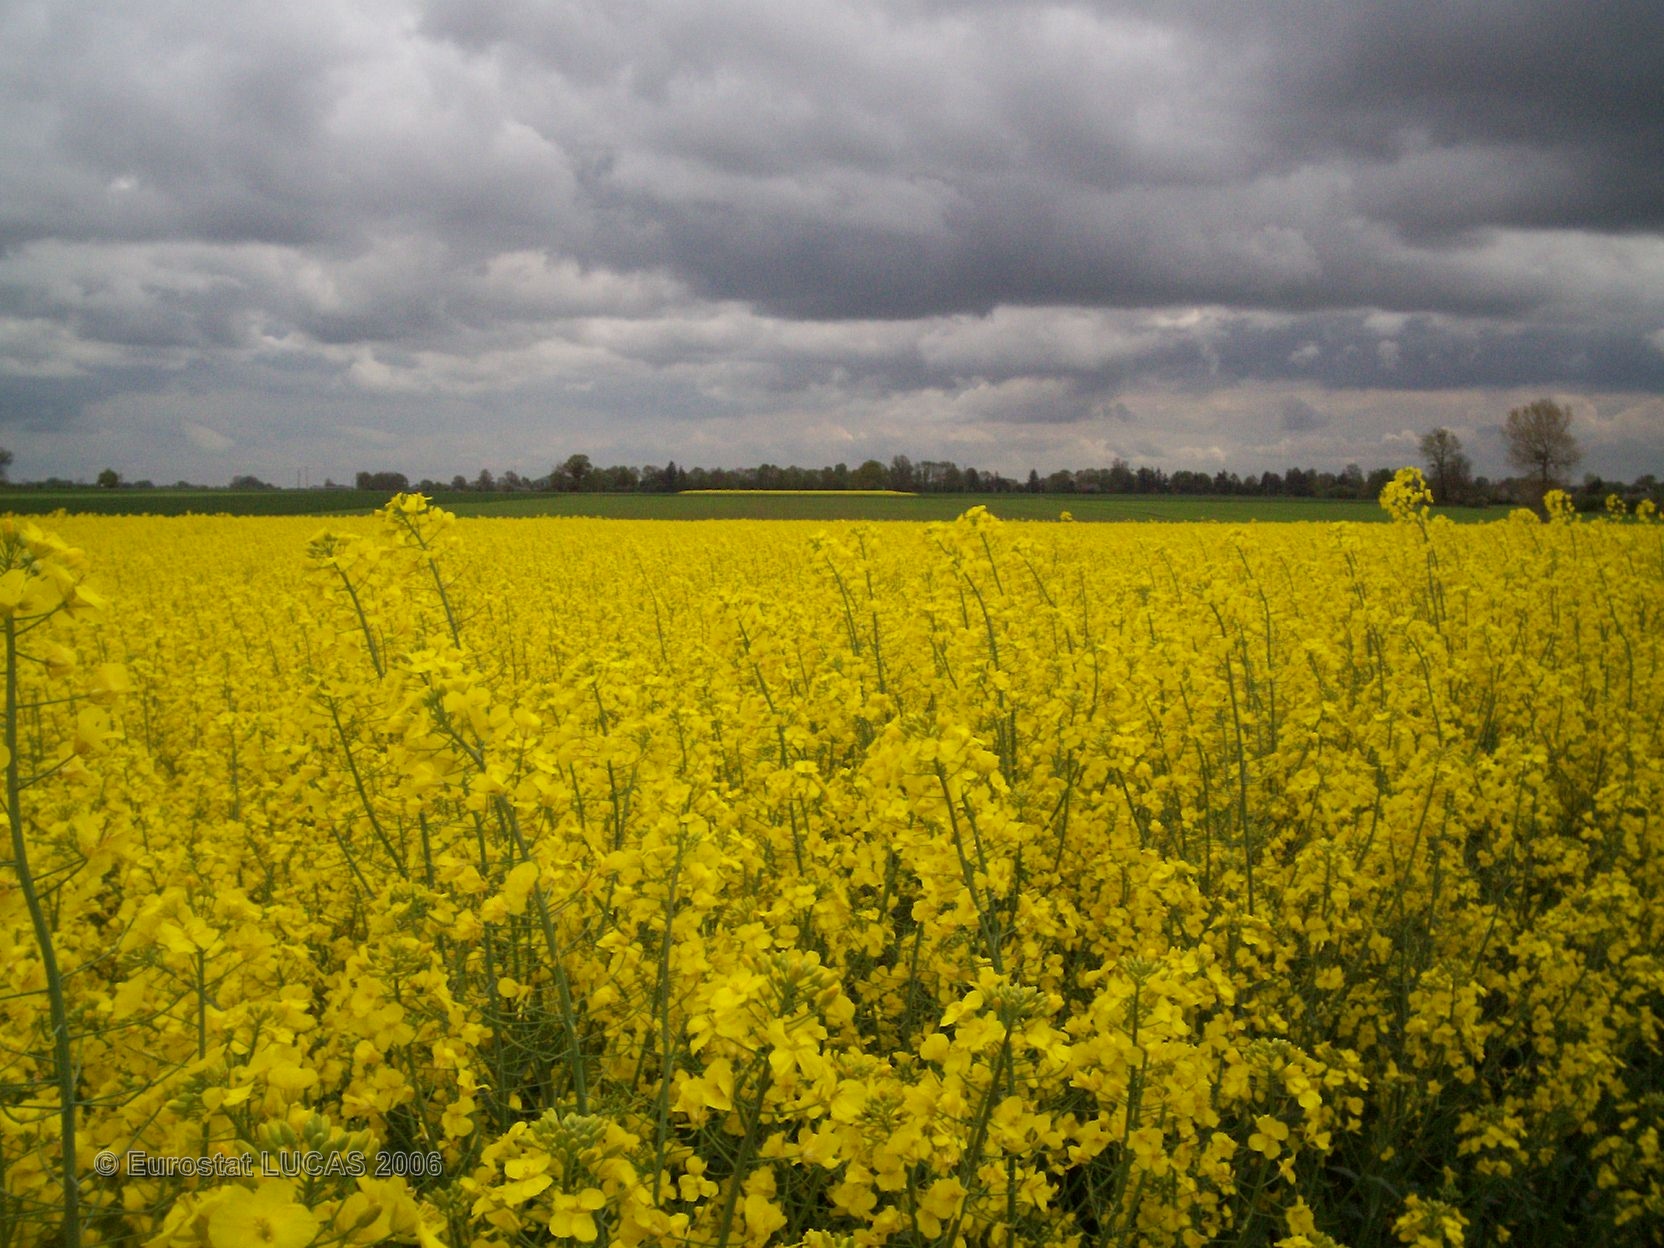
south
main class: Cropland
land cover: Rape and turnip rape
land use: Agriculture (excluding fallow land and kitchen gardens)
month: May
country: FR
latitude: 49.1529
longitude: 0.4995
